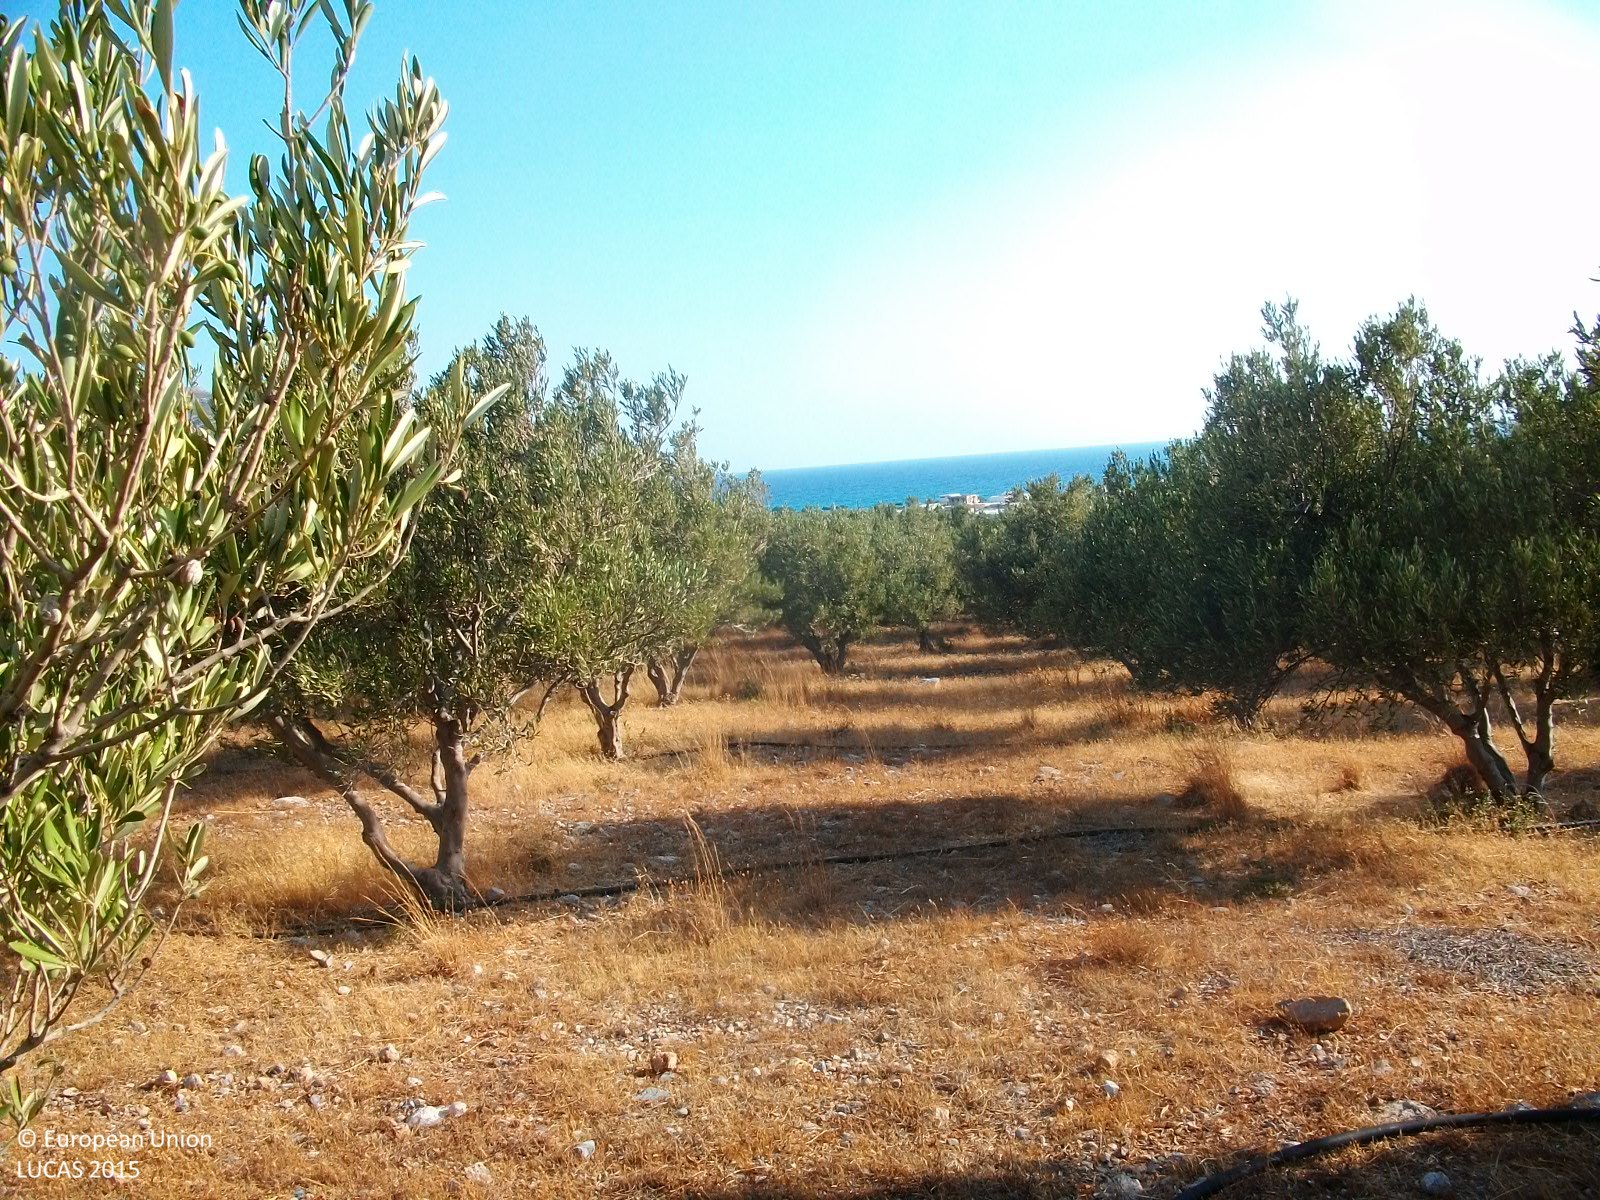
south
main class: Cropland
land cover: Olive groves
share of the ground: 25 - 50 %
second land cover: Spontaneously vegetated surfaces
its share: 50 - 75 %
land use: Agriculture (excluding fallow land and kitchen gardens)
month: August
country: GR
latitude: 35.0185
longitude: 26.0975
